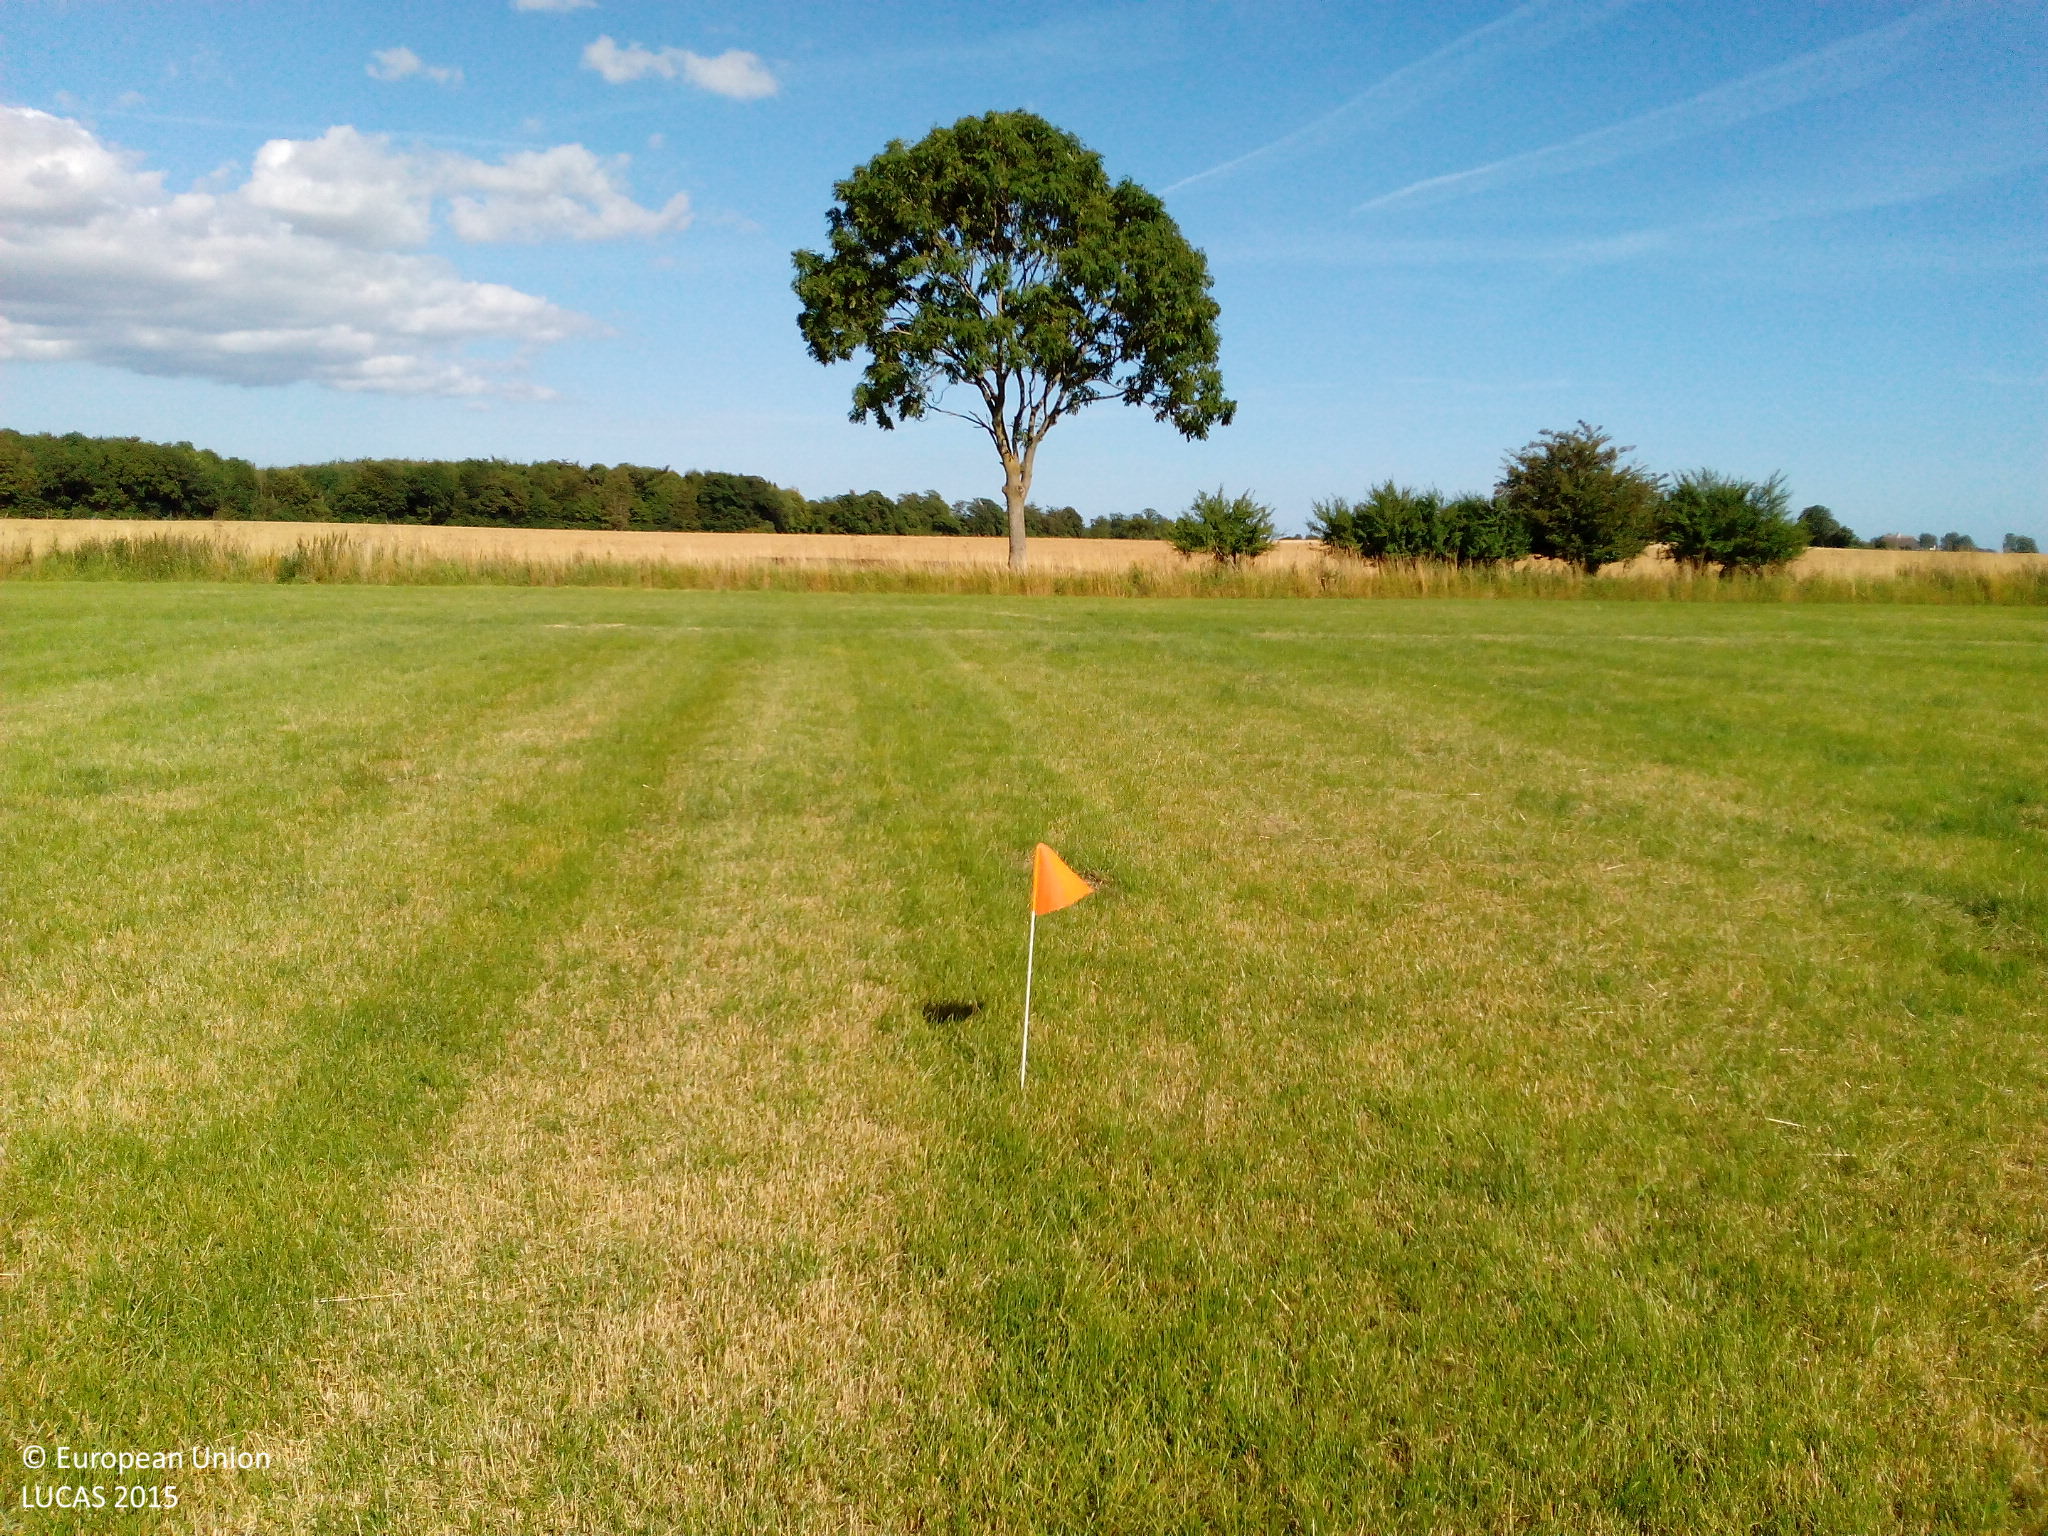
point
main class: Grassland
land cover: Grassland without tree/shrub cover
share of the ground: > 75 %
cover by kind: herbaceous plants 100 %
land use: Agriculture (excluding fallow land and kitchen gardens)
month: August
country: DK
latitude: 55.2869
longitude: 12.2500
